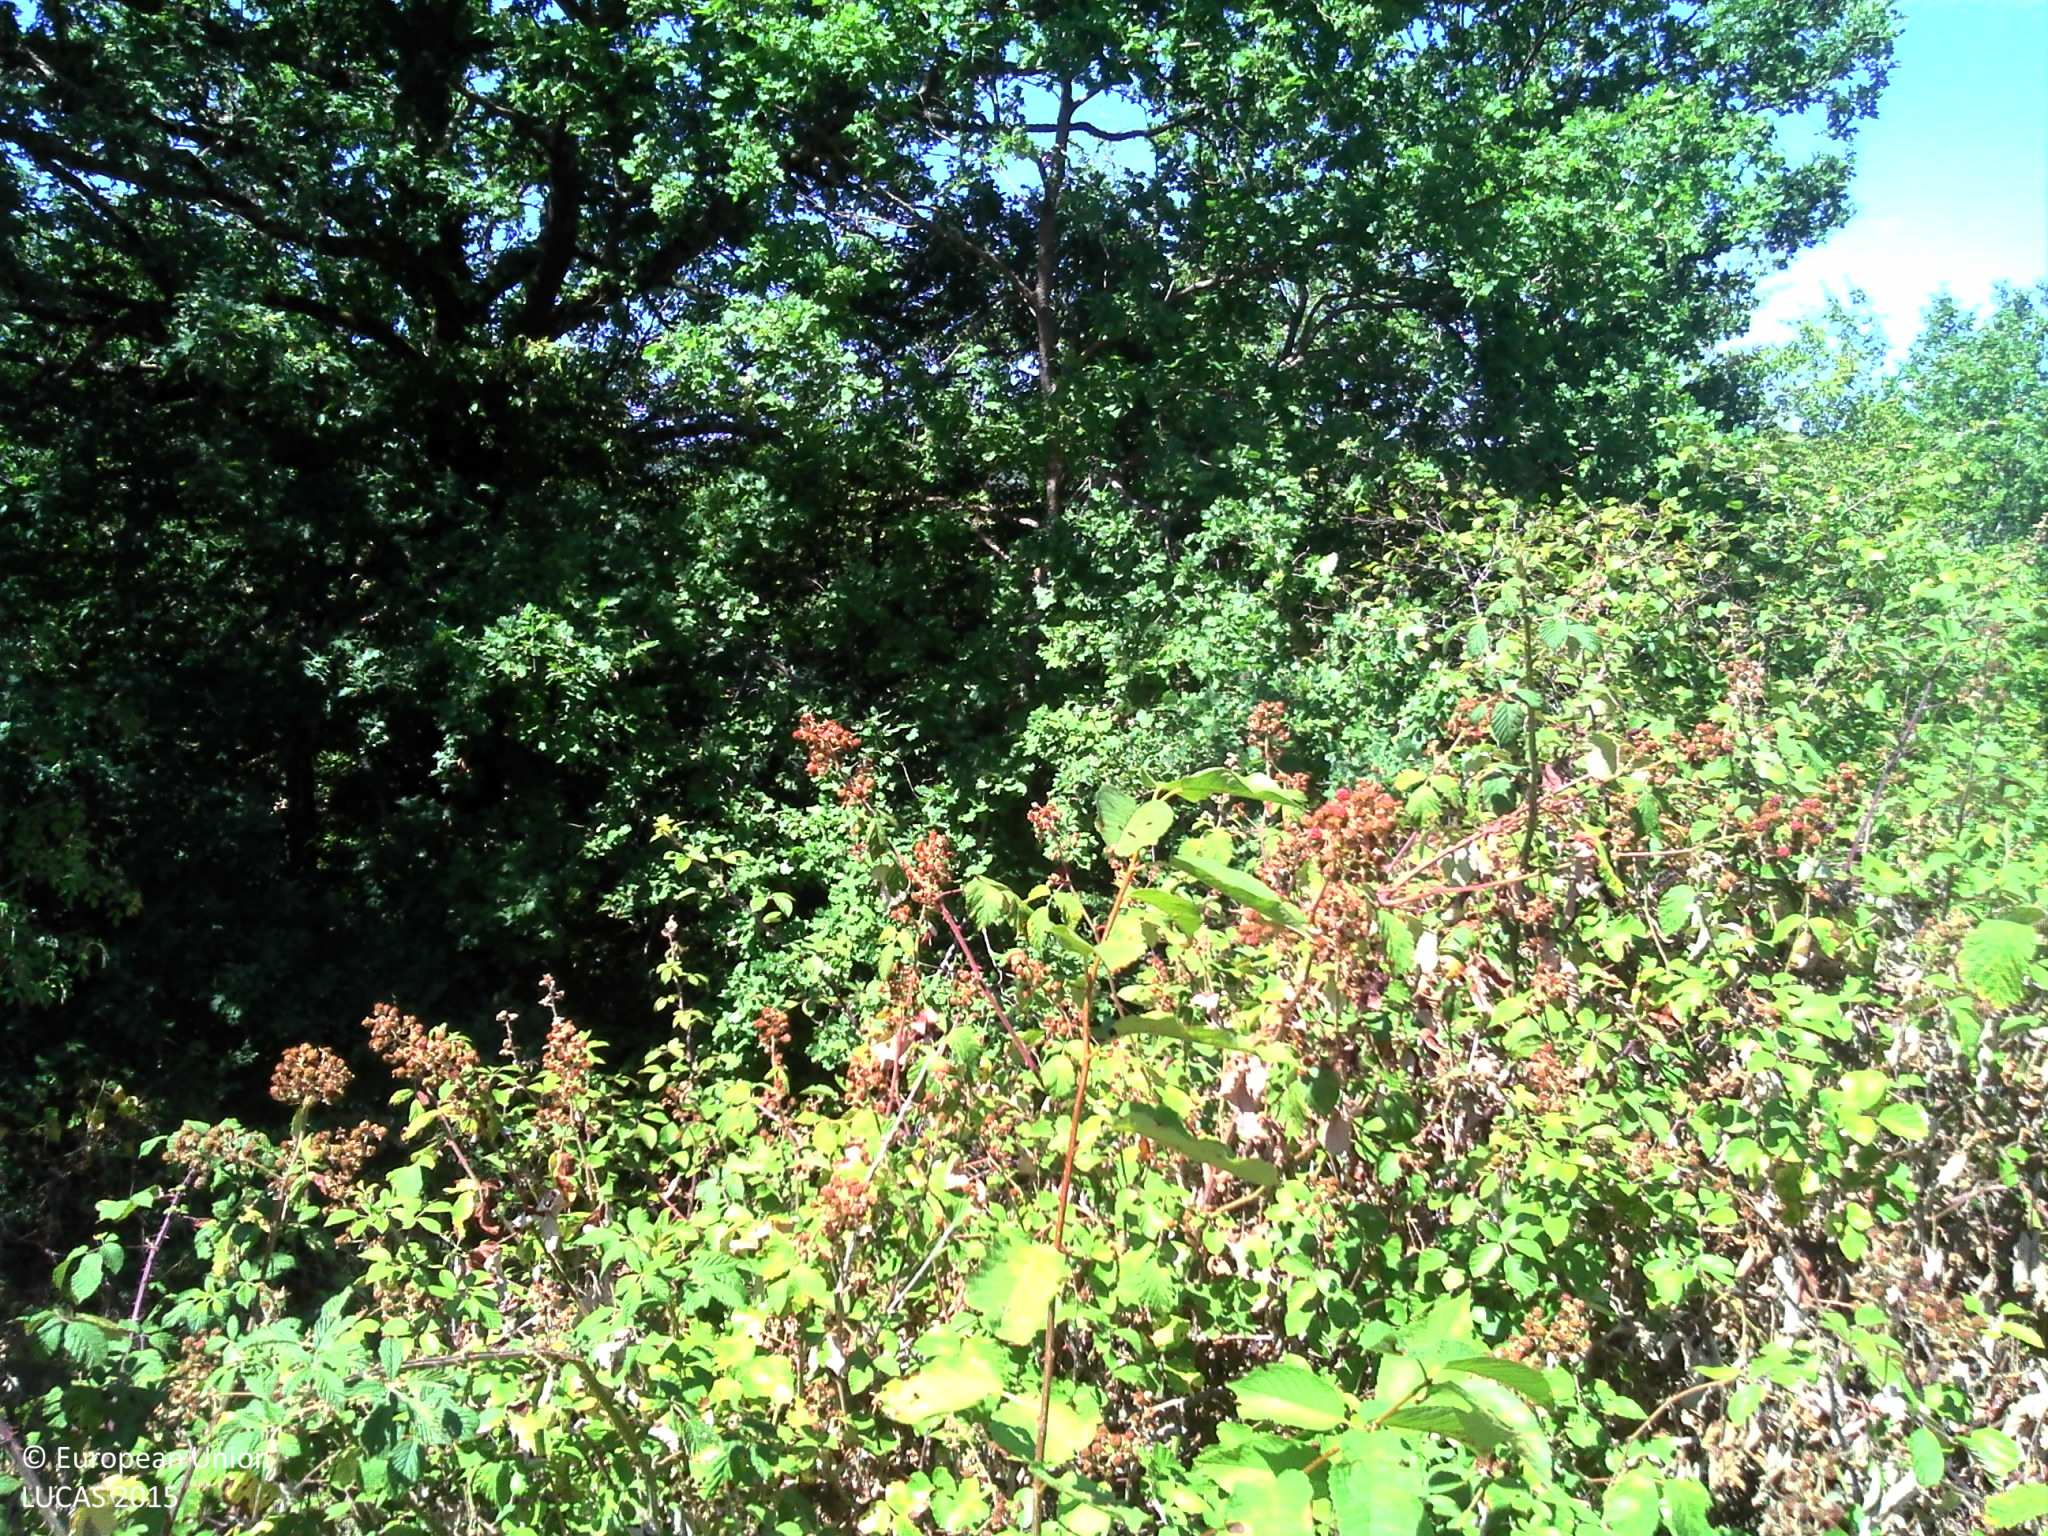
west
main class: Woodland
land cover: Broadleaved woodland
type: mesophytic deciduous forest
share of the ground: > 75 %
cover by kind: broadleaved forest trees 80 %, herbaceous plants 20 %
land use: Semi-natural and natural areas not in use
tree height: < 5 m
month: July
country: FR
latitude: 45.9413
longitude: 4.5465
